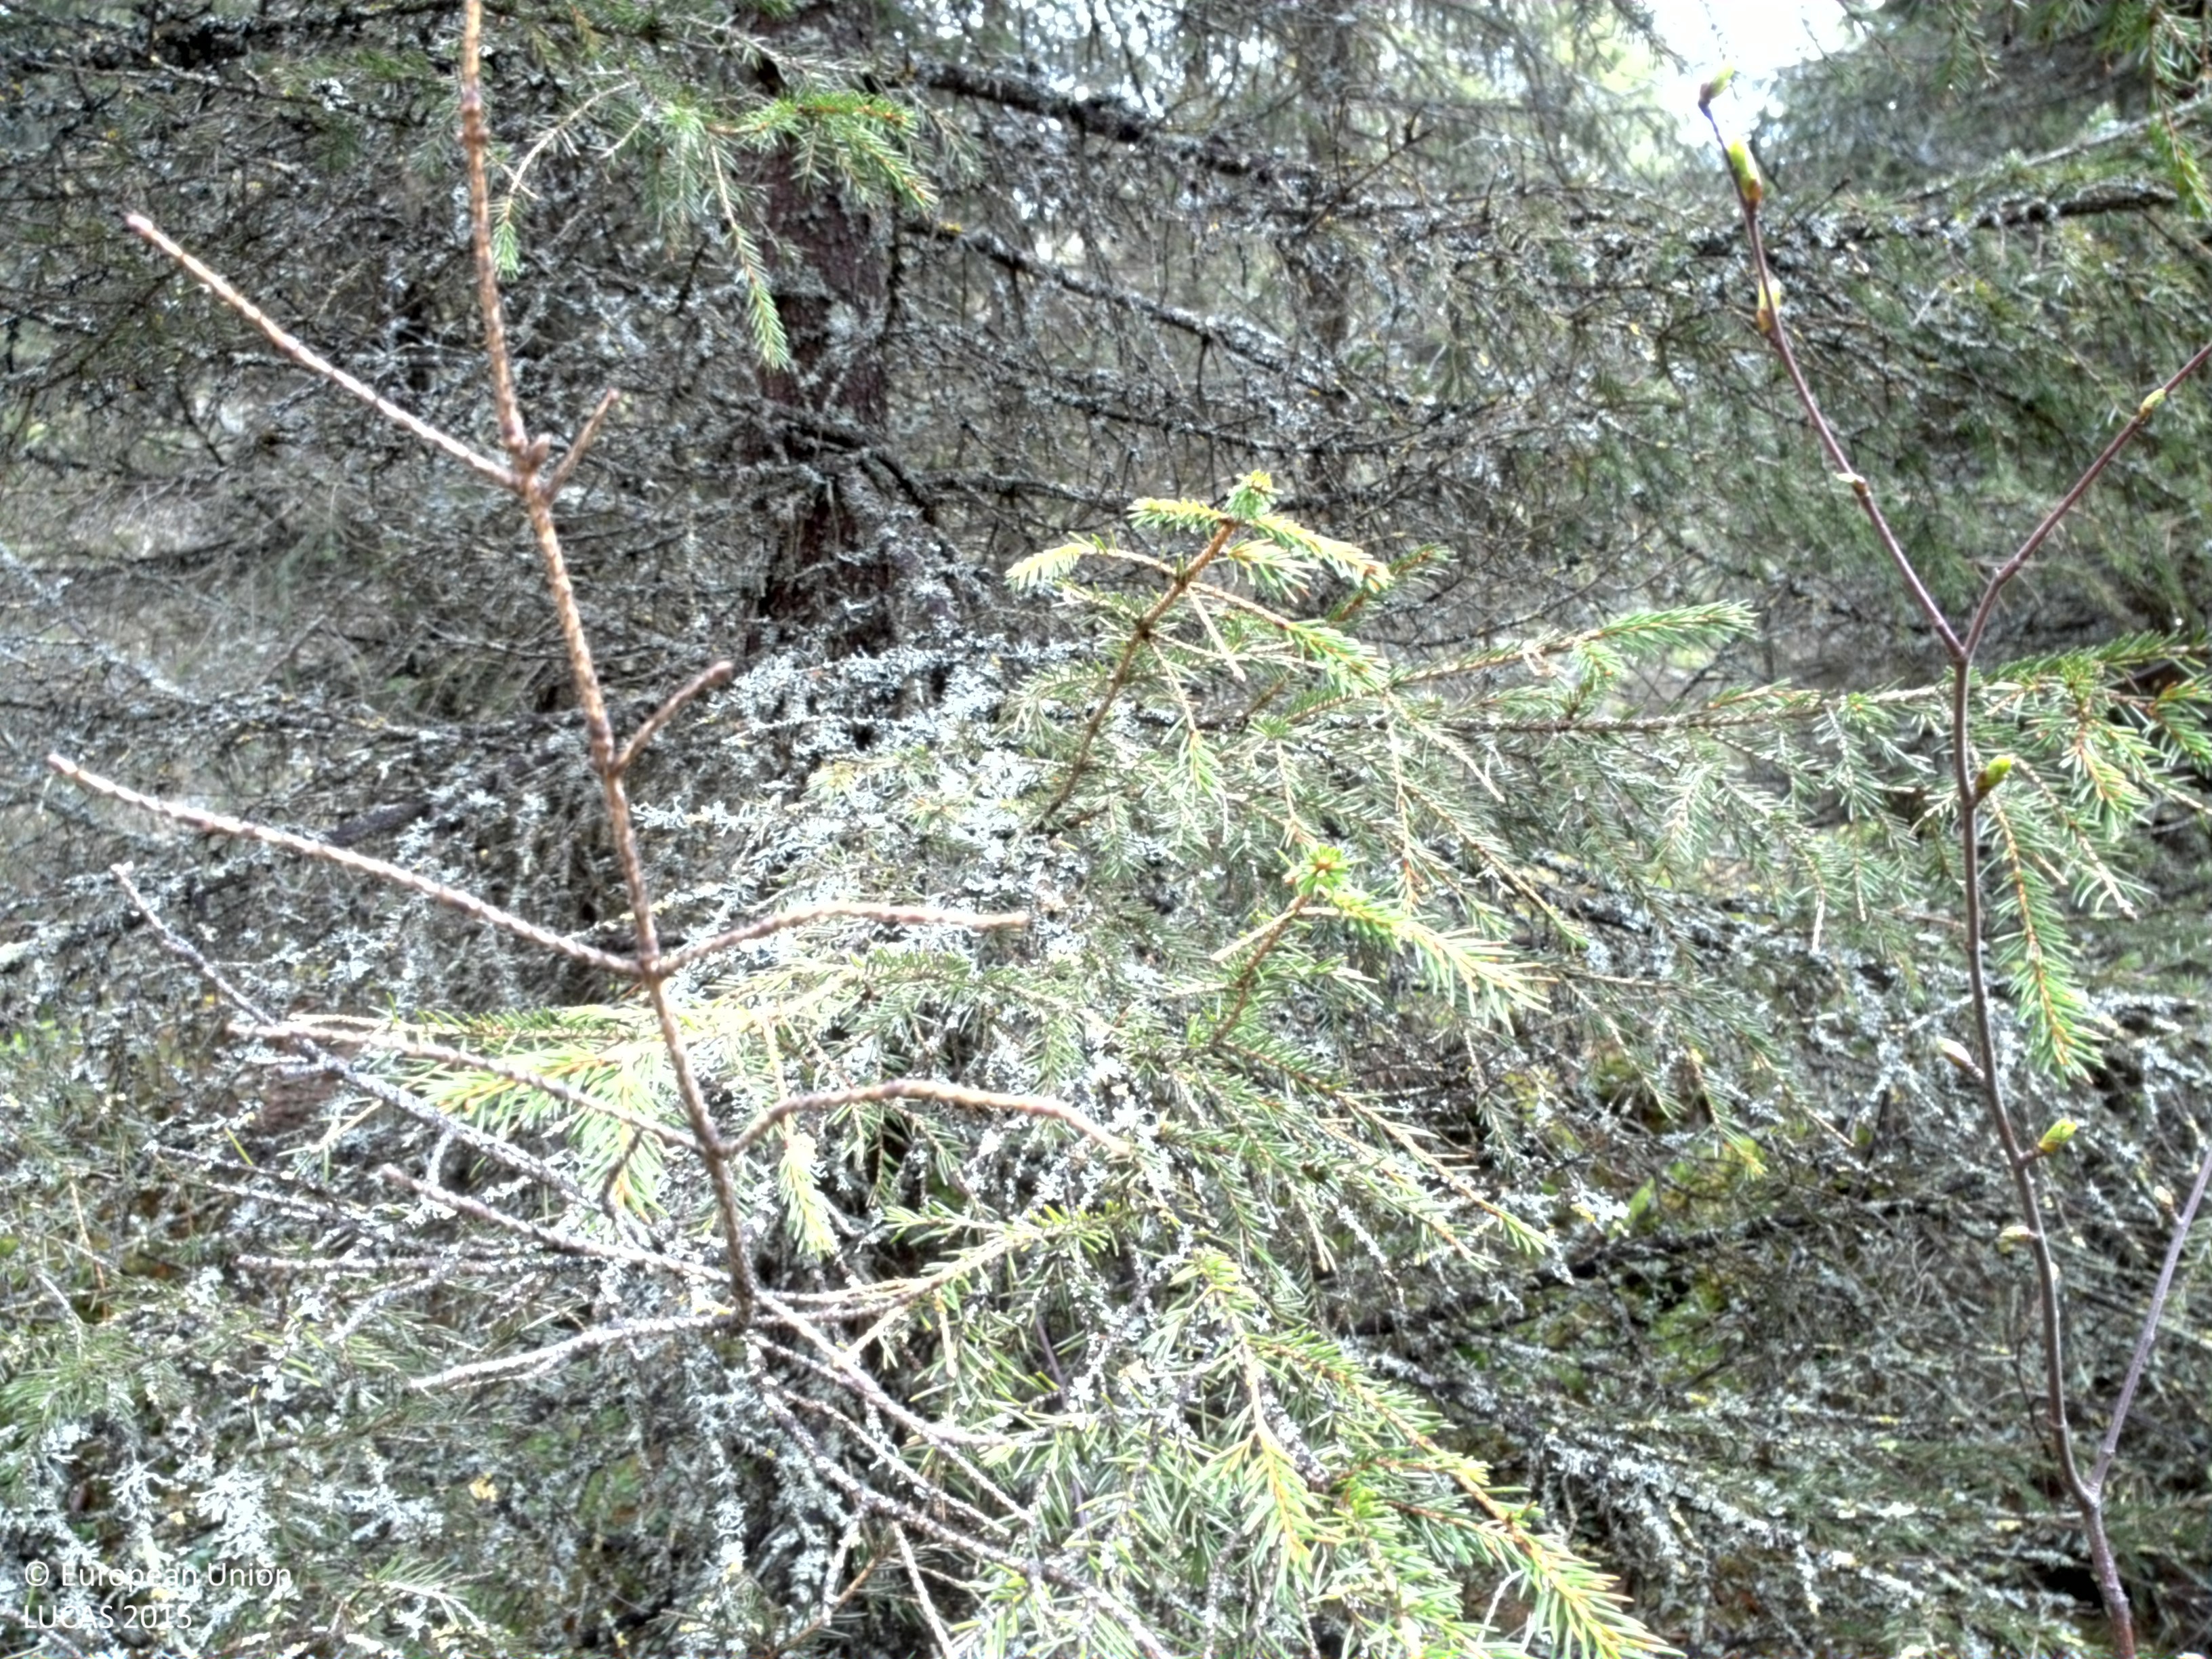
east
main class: Woodland
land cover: Spruce dominated coniferous woodland
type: boreal forest
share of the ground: > 75 %
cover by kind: coniferous forest trees 75 %, shrubs 10 %, lichens and mosses 10 %, broadleaved forest trees 5 %
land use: Forestry
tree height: > 5 m
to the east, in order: Spruce dominated coniferous woodland; Ditches and canals; Spruce dominated coniferous woodland; Ditches and canals; Shruby margins; Tracks; Groves; Ditches and canals; Pine dominated mixed woodland; Pine dominated coniferous woodland
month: May
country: SE
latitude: 66.0674
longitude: 23.6672
